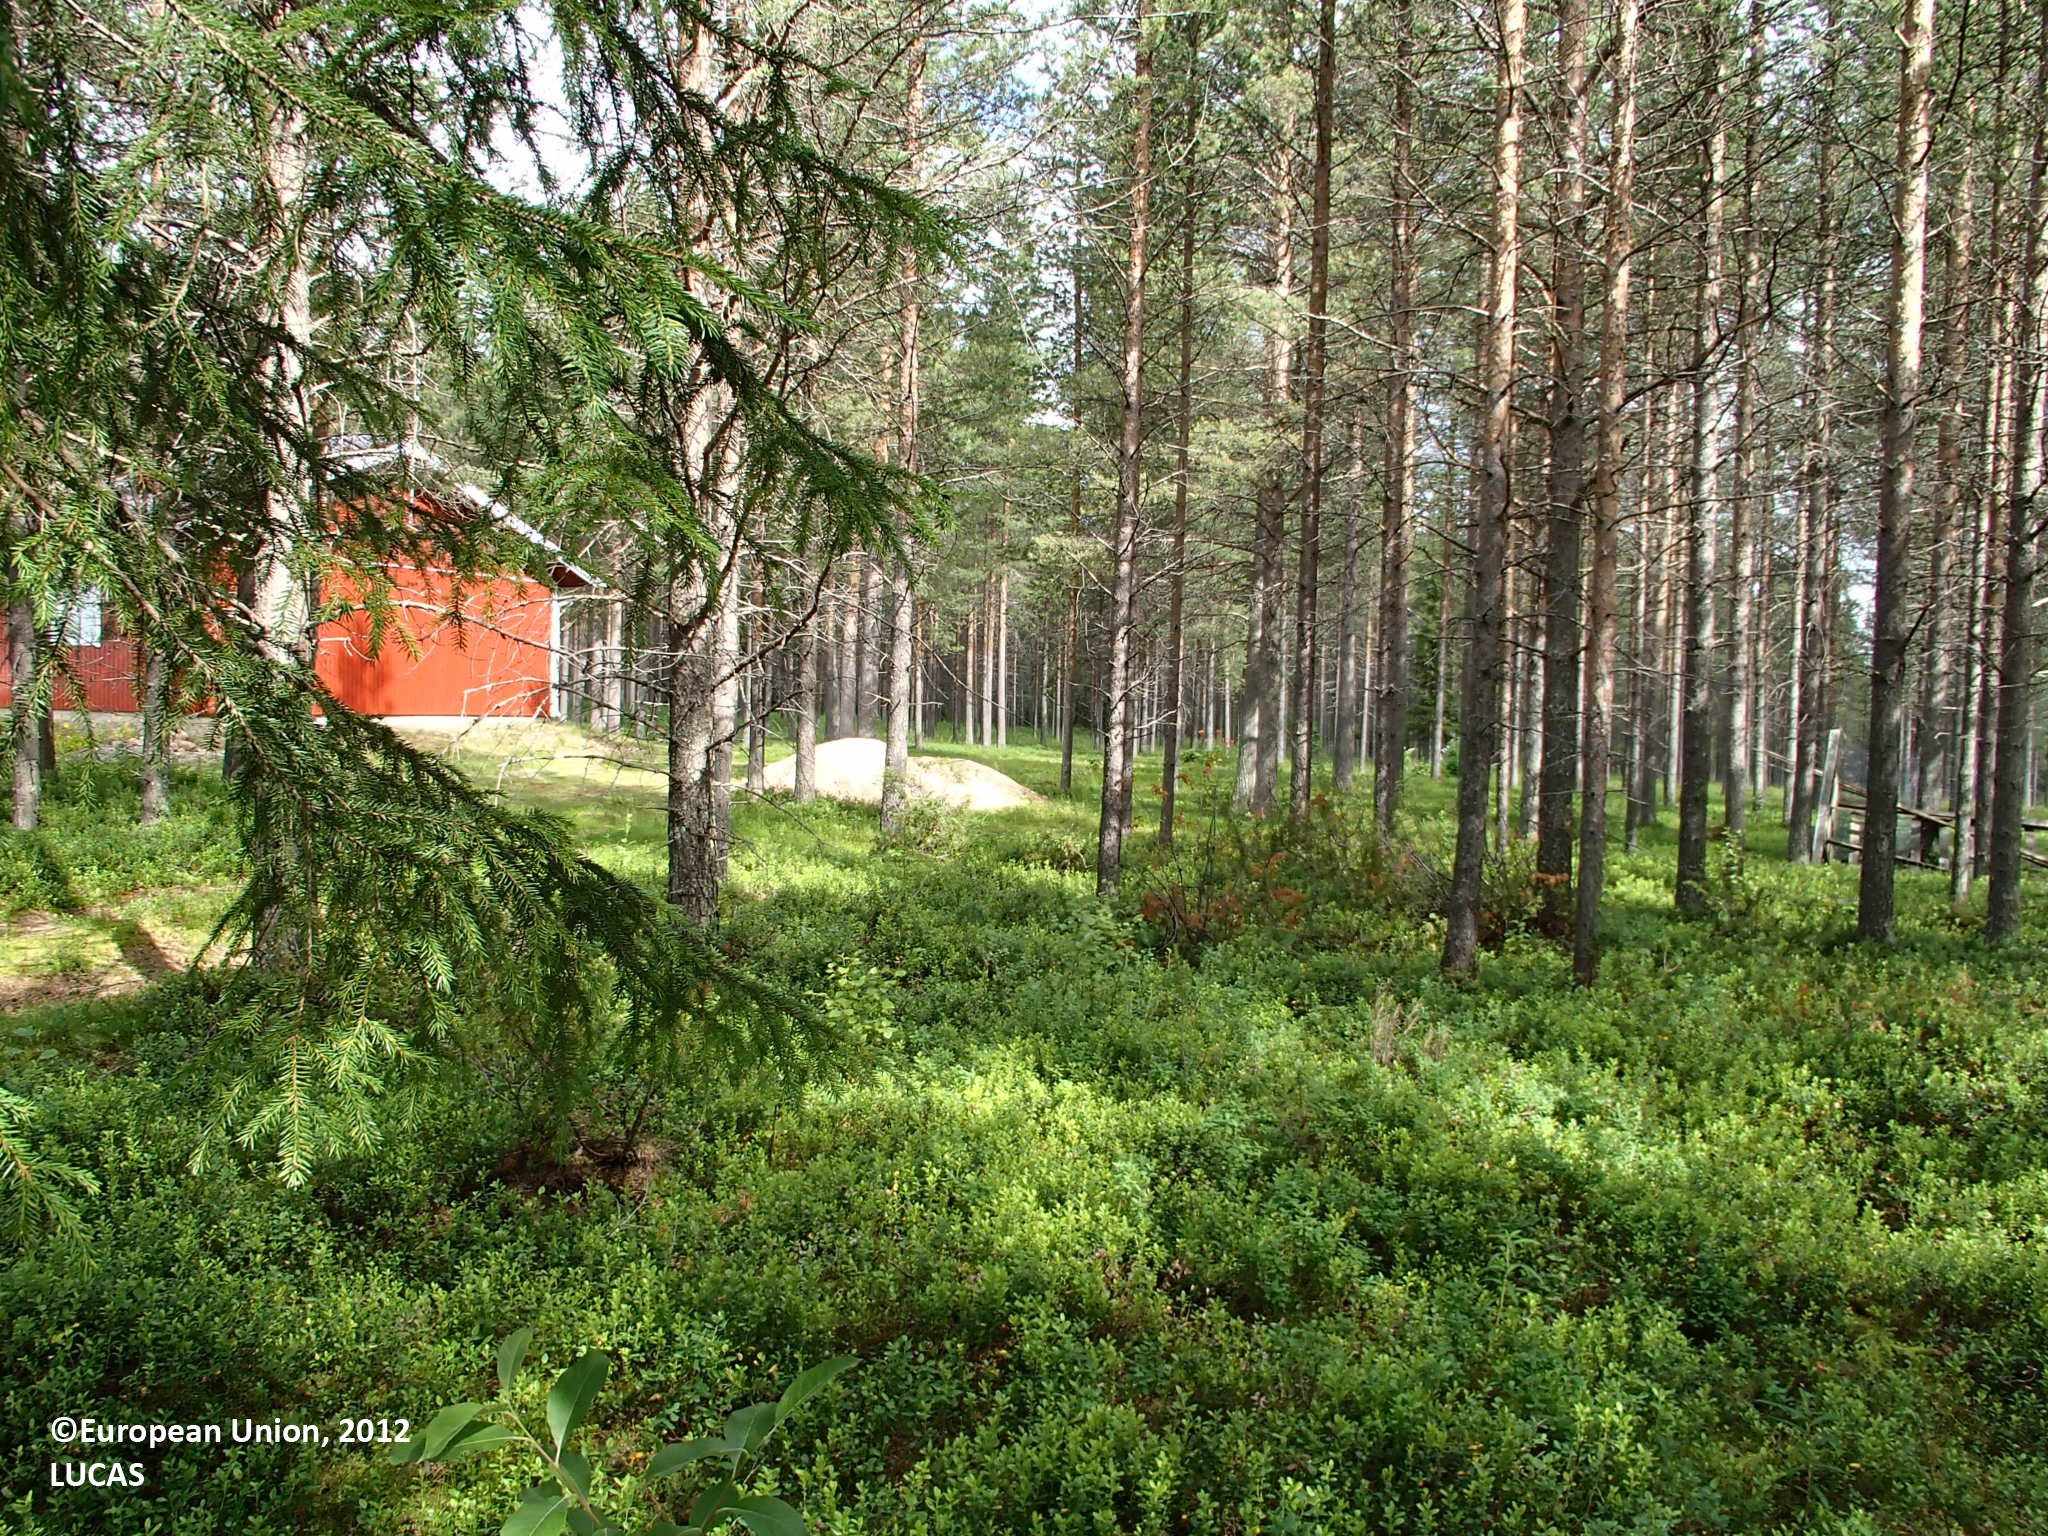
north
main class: Woodland
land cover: Pine dominated coniferous woodland
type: boreal forest
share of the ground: > 75 %
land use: Forestry
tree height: > 5 m
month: July
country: FI
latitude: 67.2762
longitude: 25.5262
